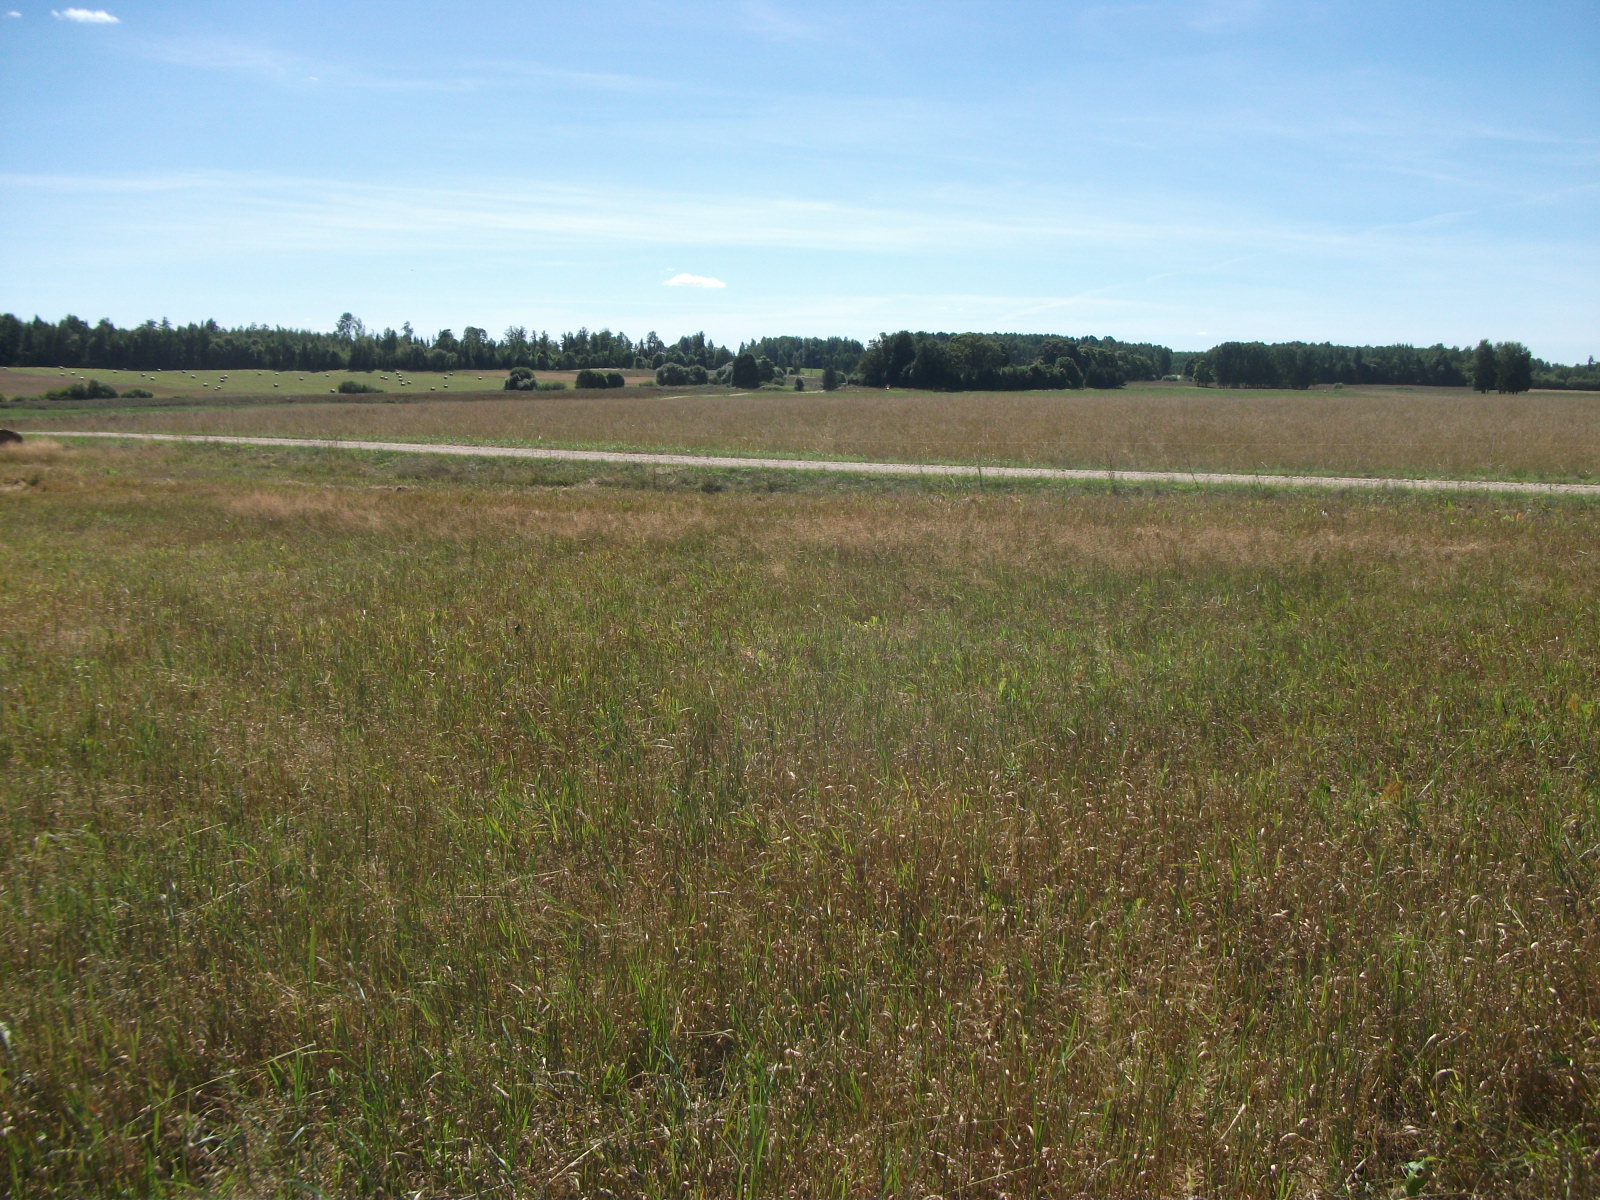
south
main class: Grassland
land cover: Grassland without tree/shrub cover
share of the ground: > 75 %
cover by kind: herbaceous plants 100 %
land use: Agriculture (excluding fallow land and kitchen gardens)
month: August
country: LV
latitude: 56.6807
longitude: 26.1498
